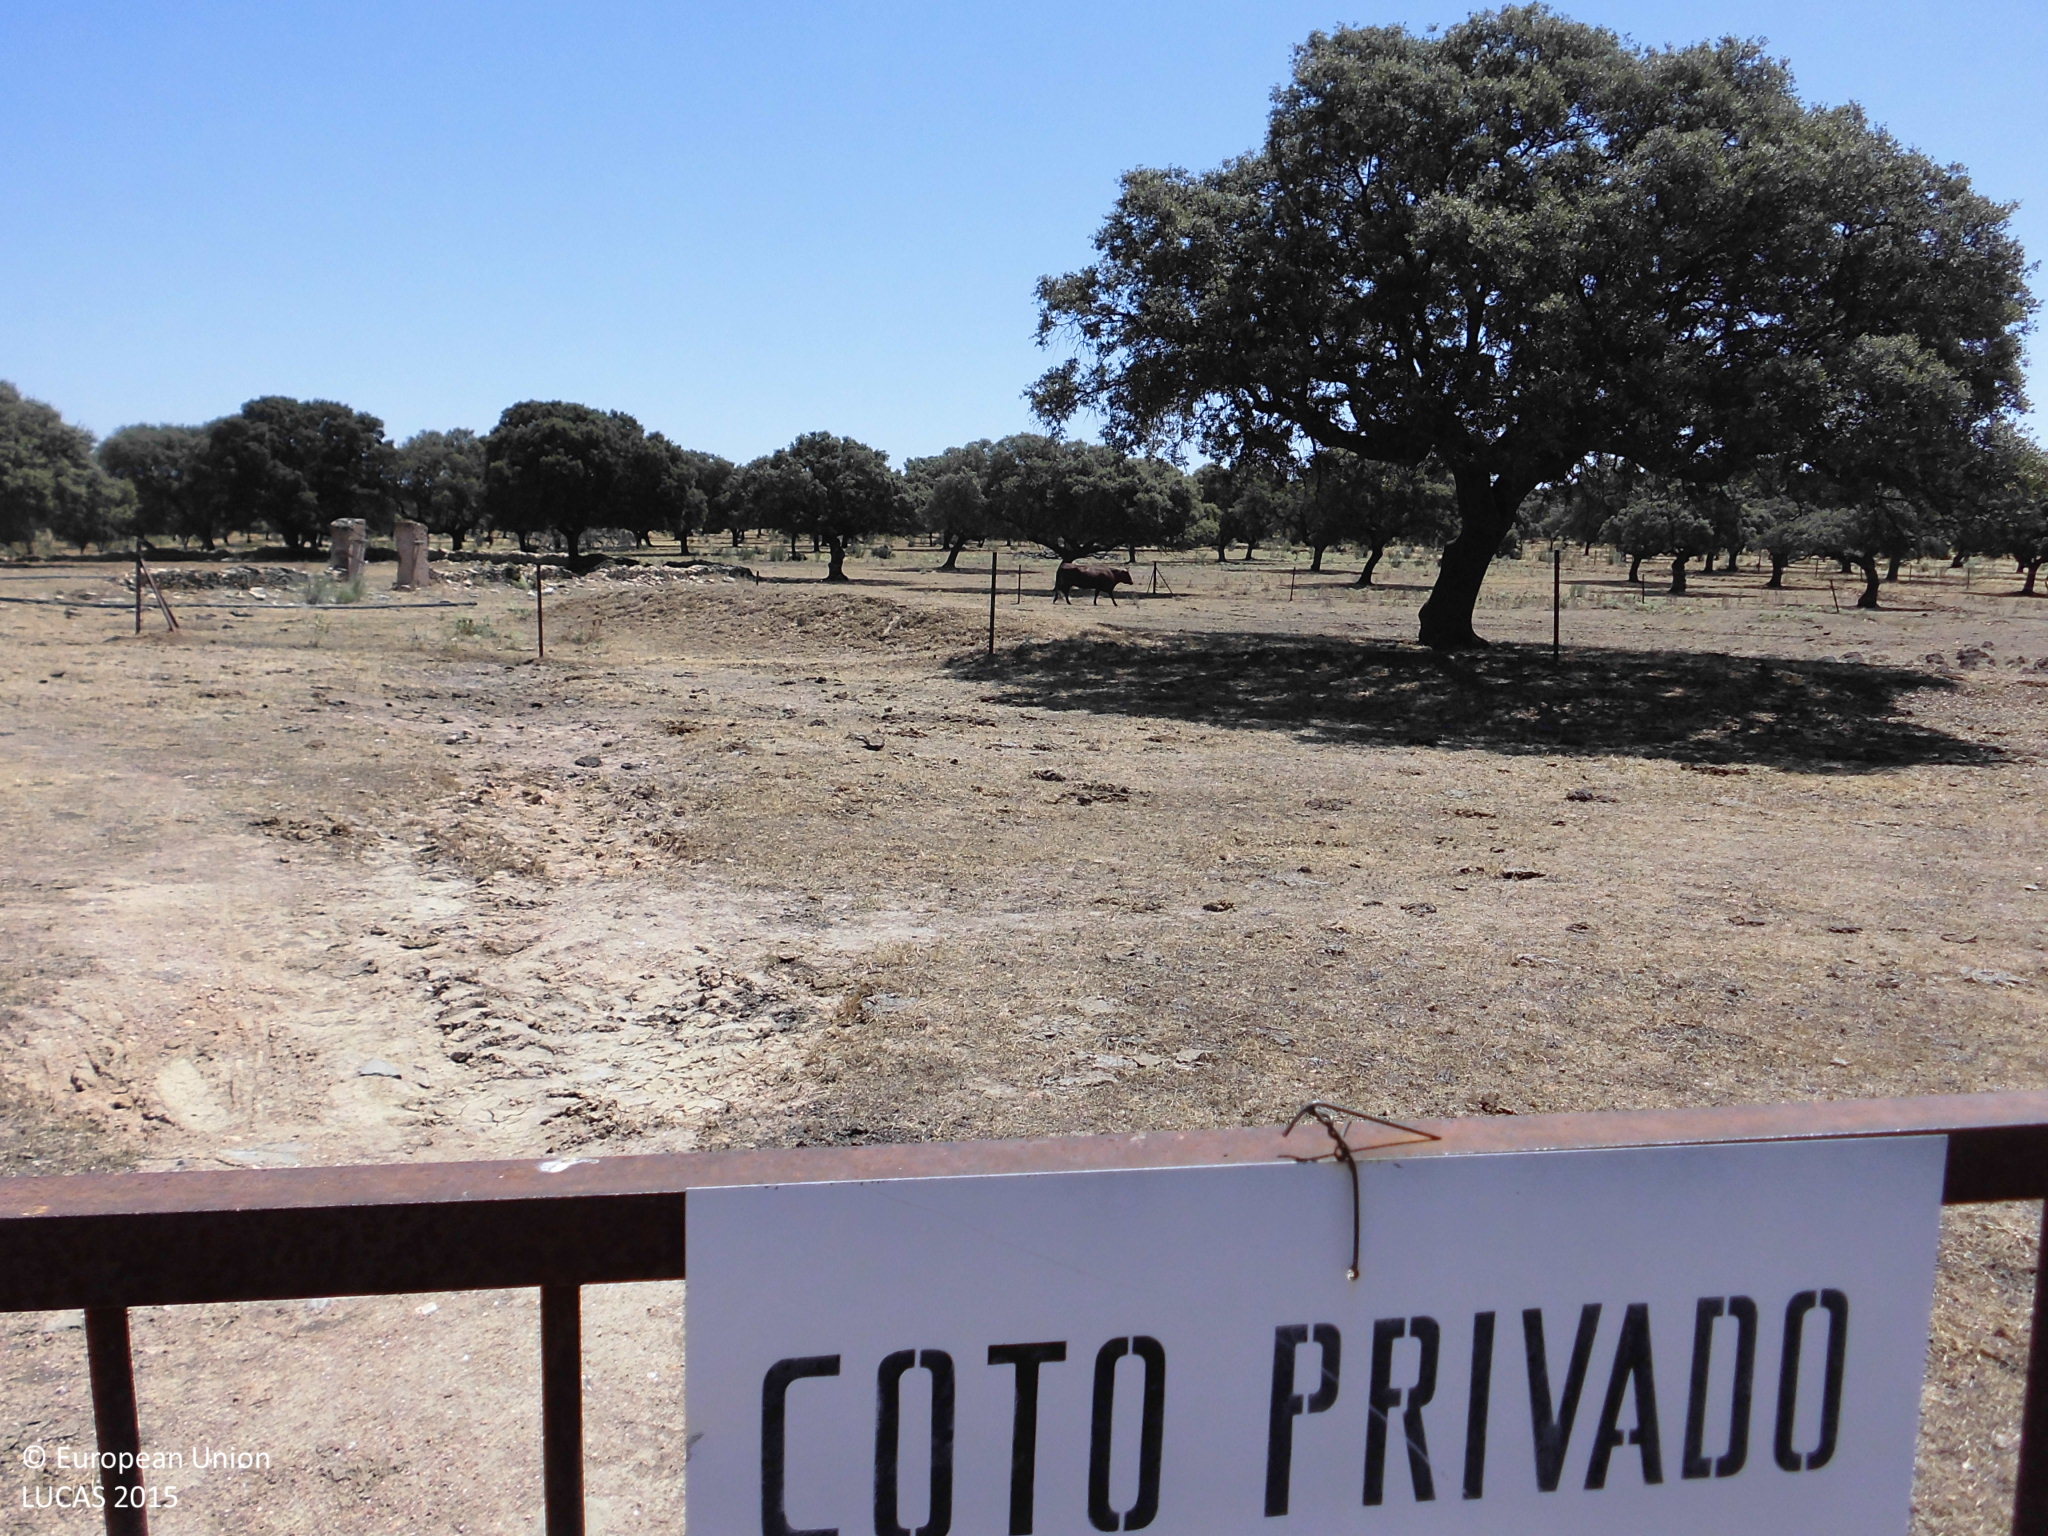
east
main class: Woodland
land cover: Broadleaved woodland
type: broadleaved evergreen forest
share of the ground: 10 - 25 %
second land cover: Grassland without tree/shrub cover
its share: > 75 %
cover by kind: herbaceous plants 75 %, broadleaved forest trees 25 %
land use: Forestry
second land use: Agriculture (excluding fallow land and kitchen gardens)
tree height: > 5 m
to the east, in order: Broadleaved woodland; Grassland without tree/shrub cover; Broadleaved woodland; Rivers and streams; Broadleaved woodland
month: June
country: ES
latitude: 39.6981
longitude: -6.0065
